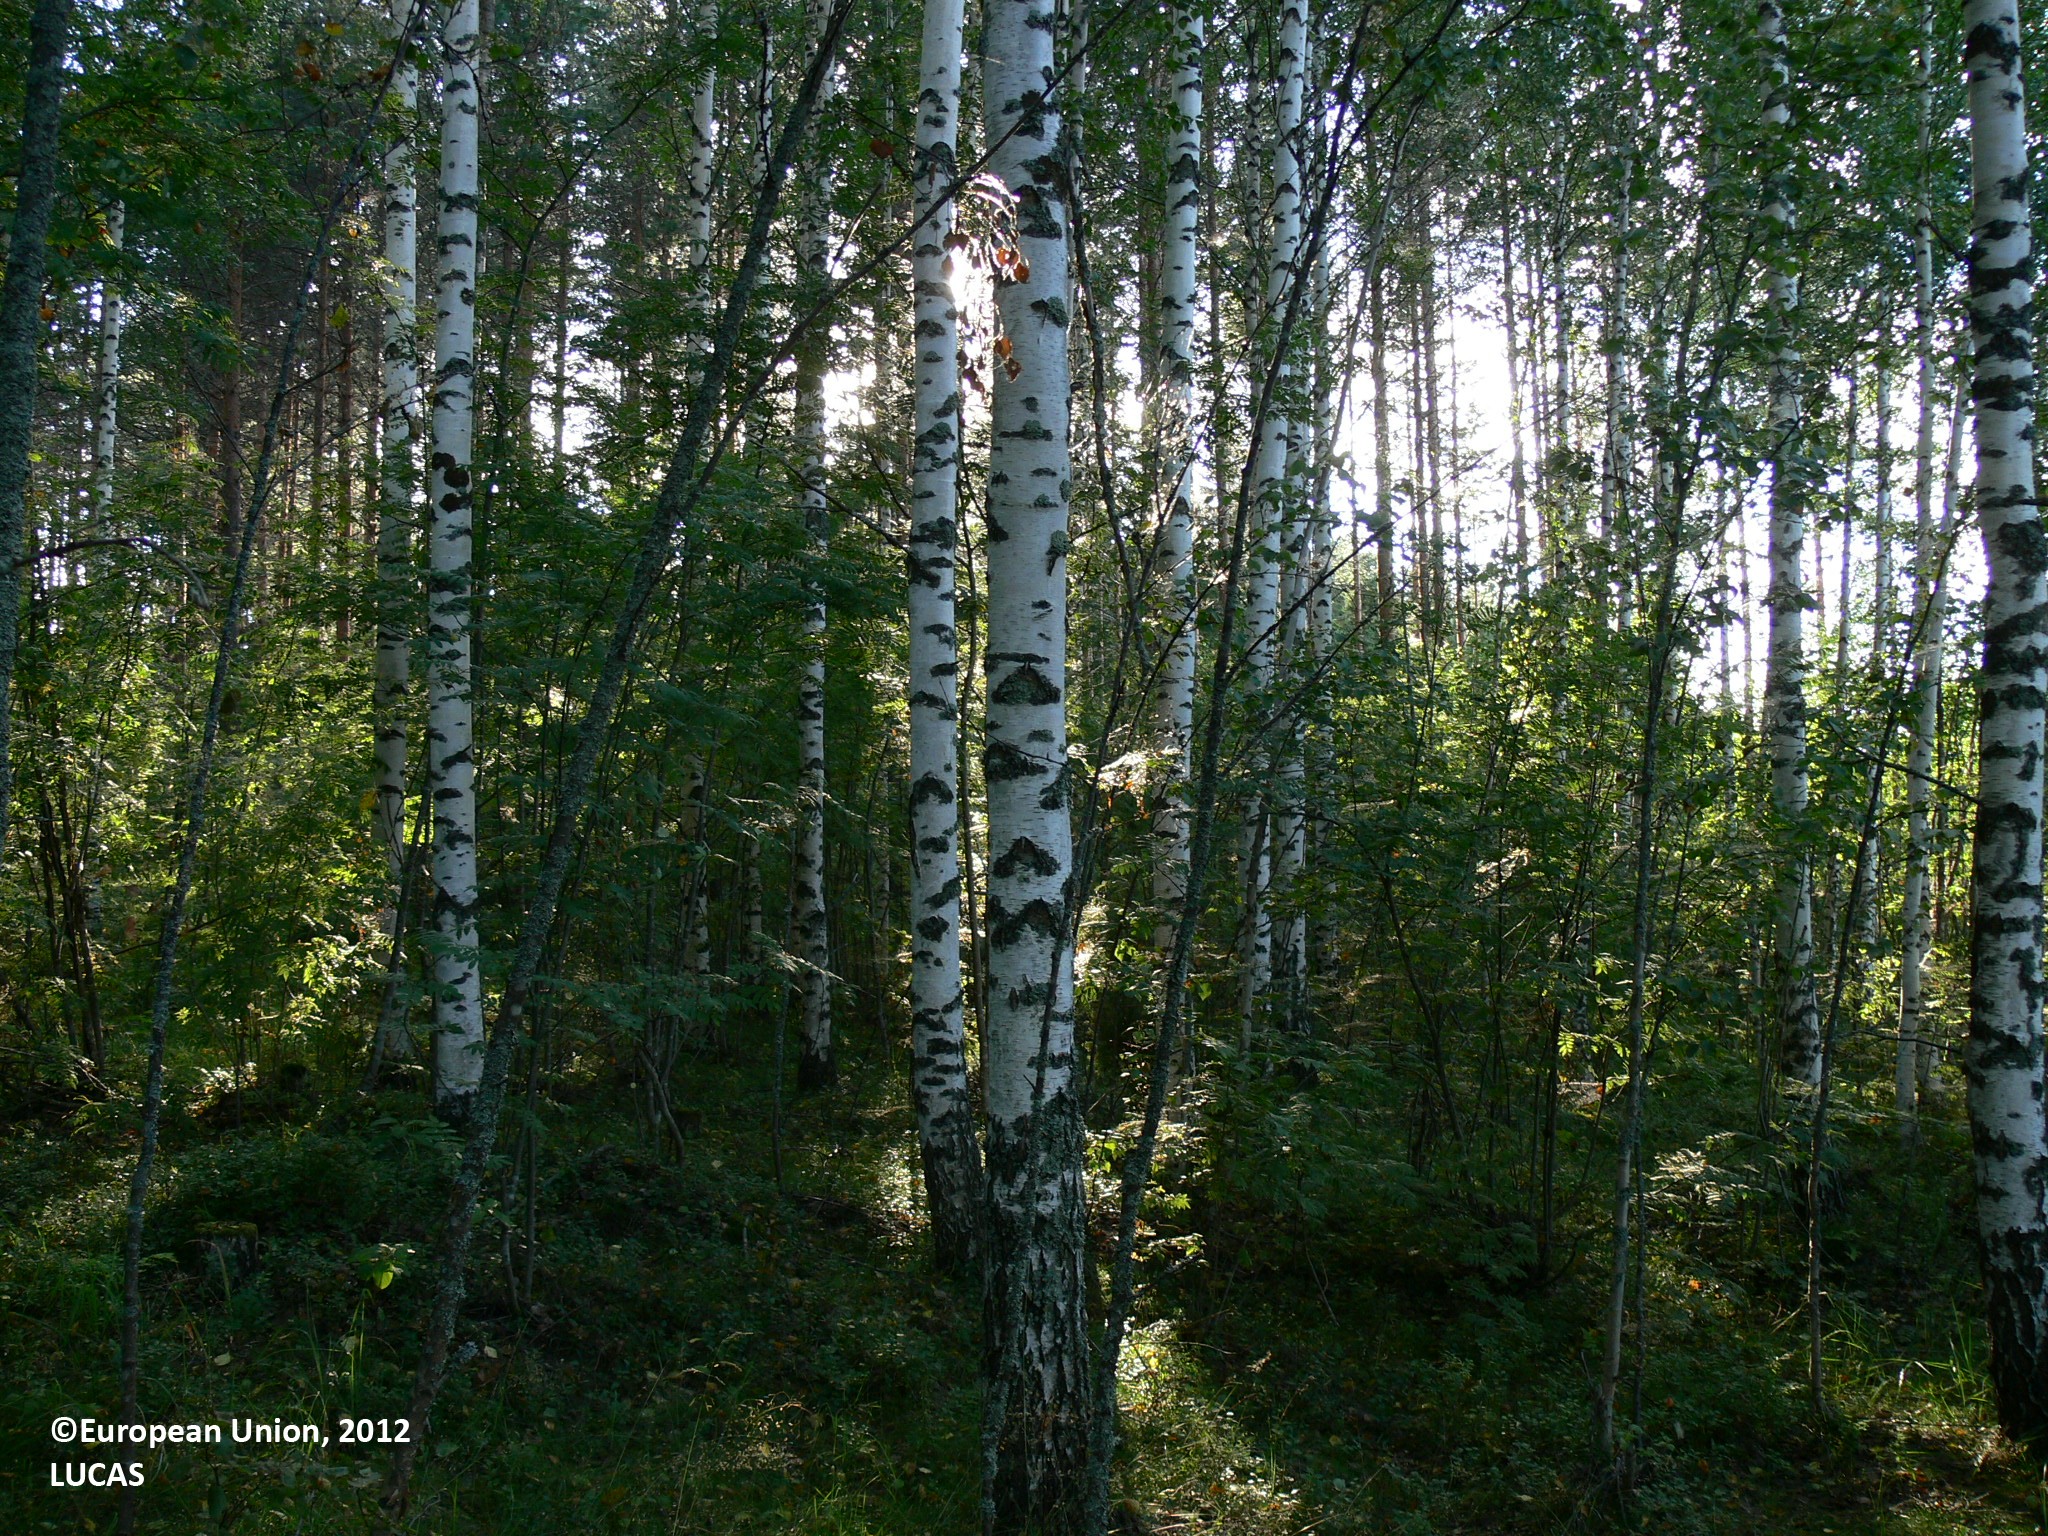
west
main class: Woodland
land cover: Broadleaved woodland
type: boreal forest
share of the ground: > 75 %
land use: Forestry
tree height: > 5 m
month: August
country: FI
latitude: 61.9926
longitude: 29.1884
